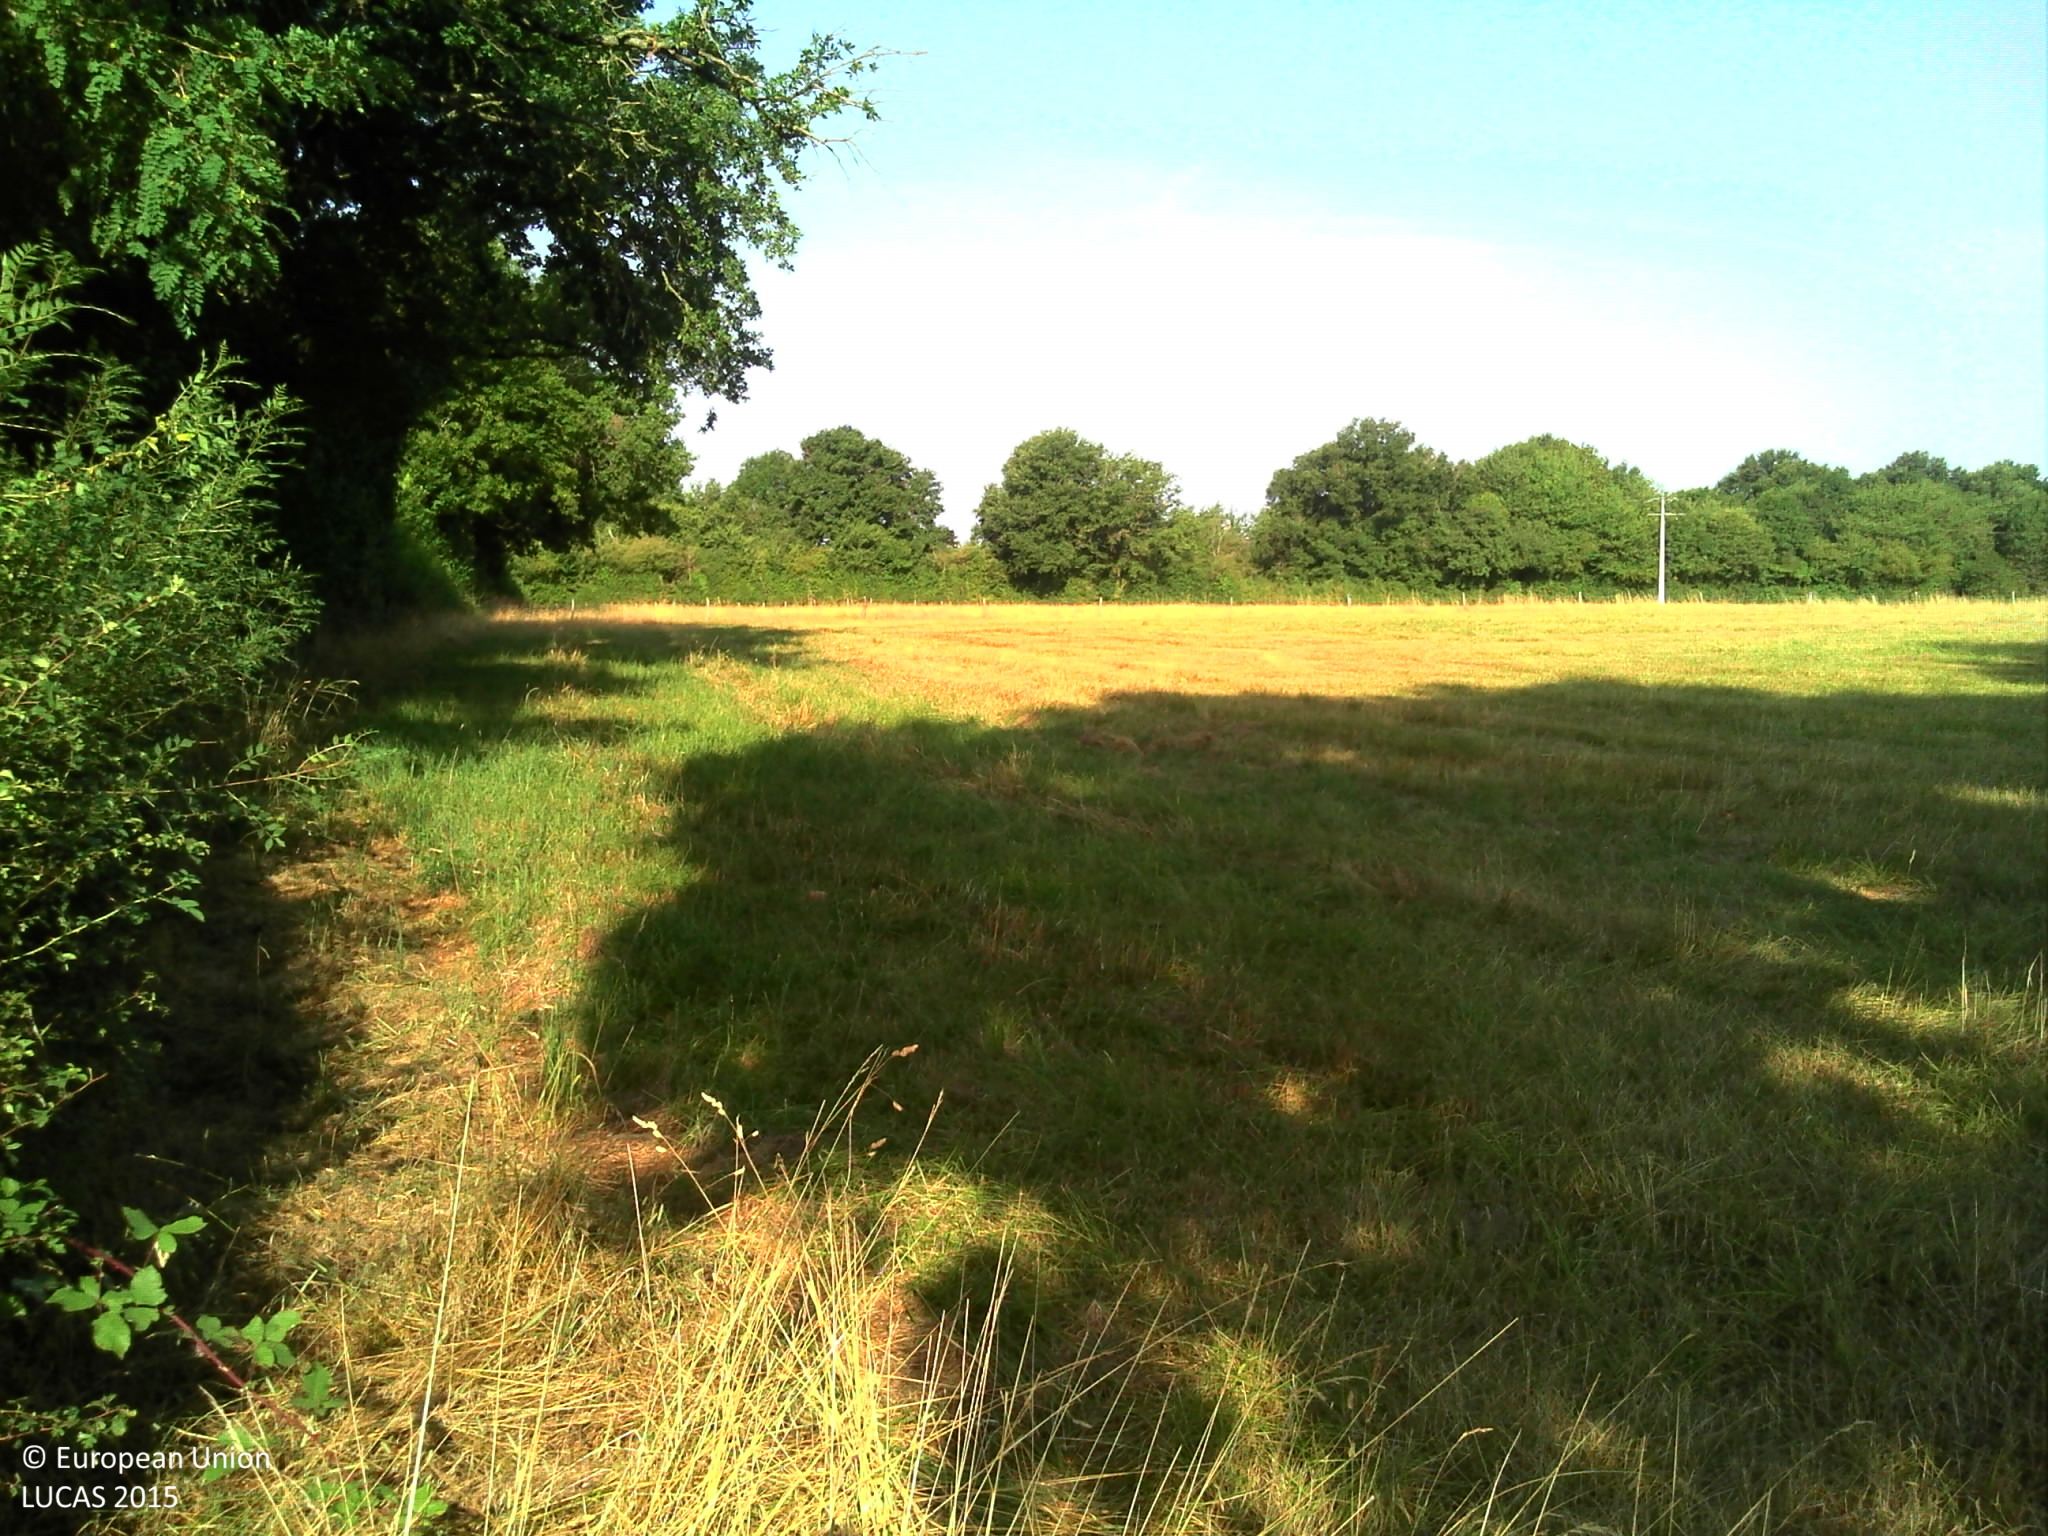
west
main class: Grassland
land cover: Grassland without tree/shrub cover
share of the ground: > 75 %
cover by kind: herbaceous plants 100 %
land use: Agriculture (excluding fallow land and kitchen gardens)
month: July
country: FR
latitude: 46.2676
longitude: 0.6557
